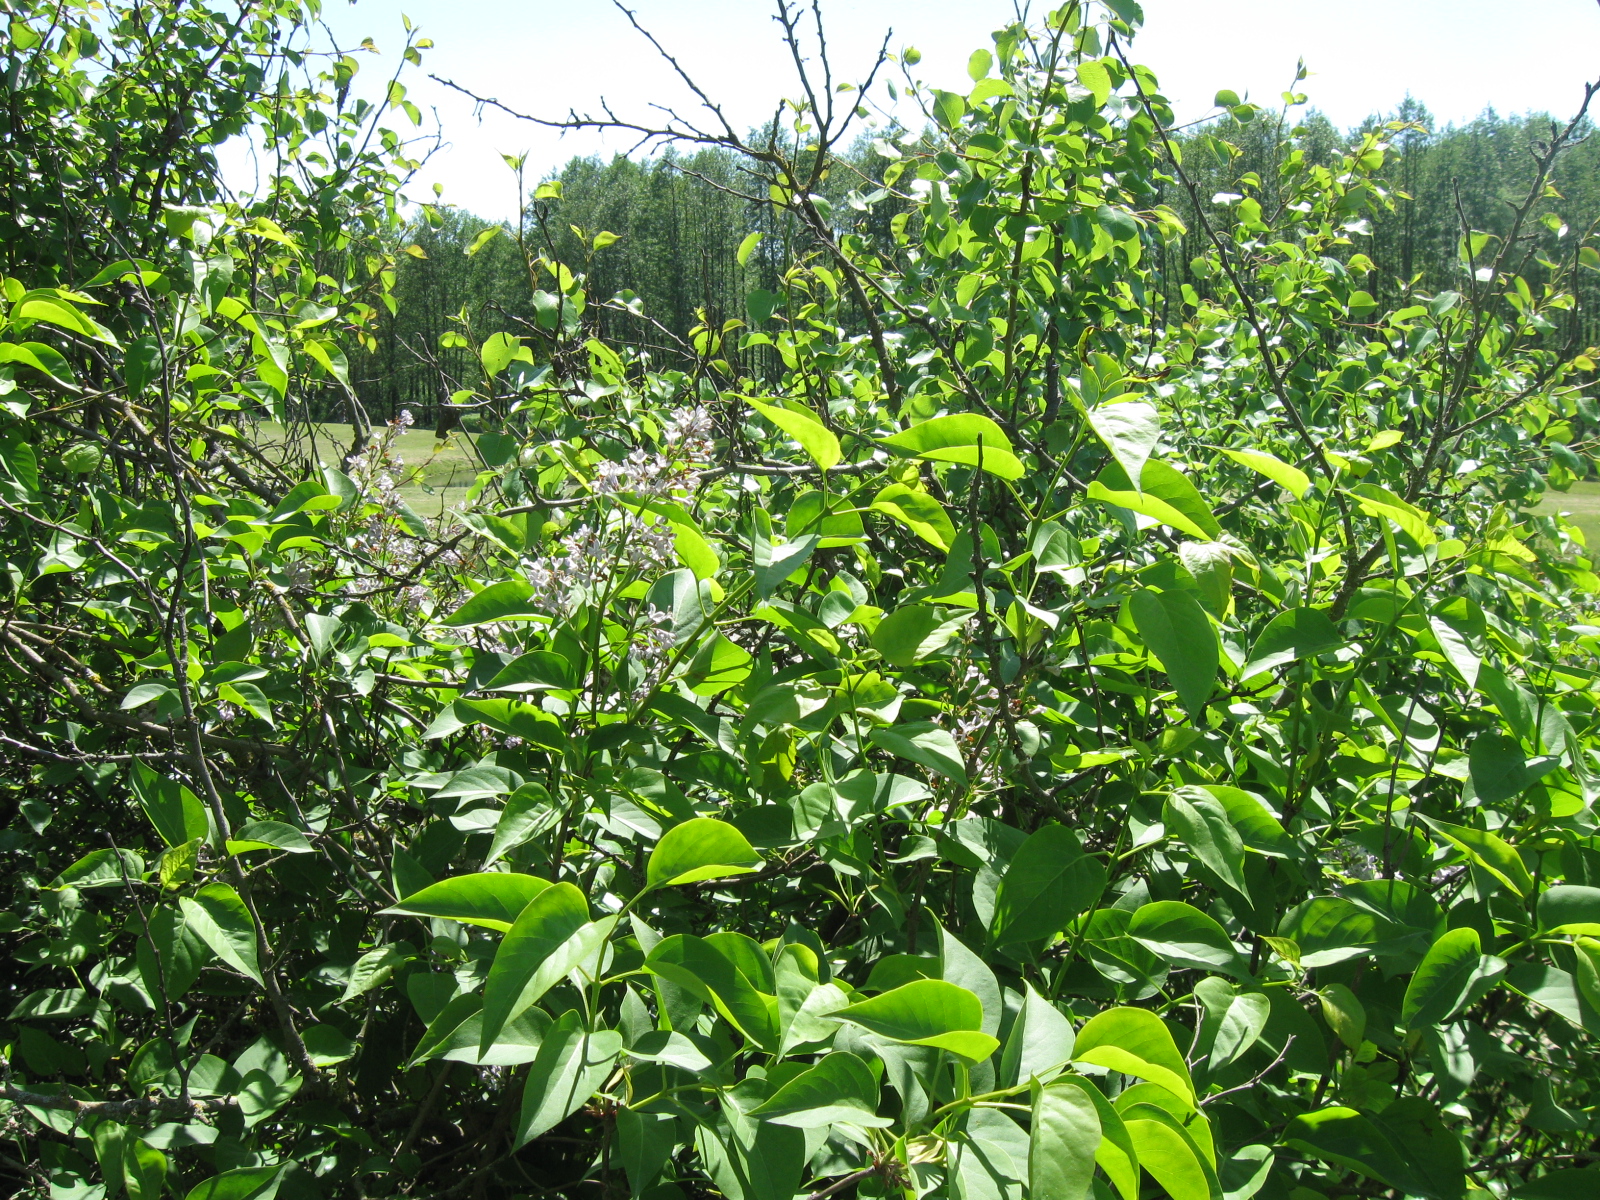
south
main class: Woodland
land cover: Broadleaved woodland
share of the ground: 25 - 50 %
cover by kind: broadleaved forest trees 45 %, herbaceous plants 40 %, shrubs 15 %
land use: Forestry
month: June
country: LT
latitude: 54.0949
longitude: 23.5547
